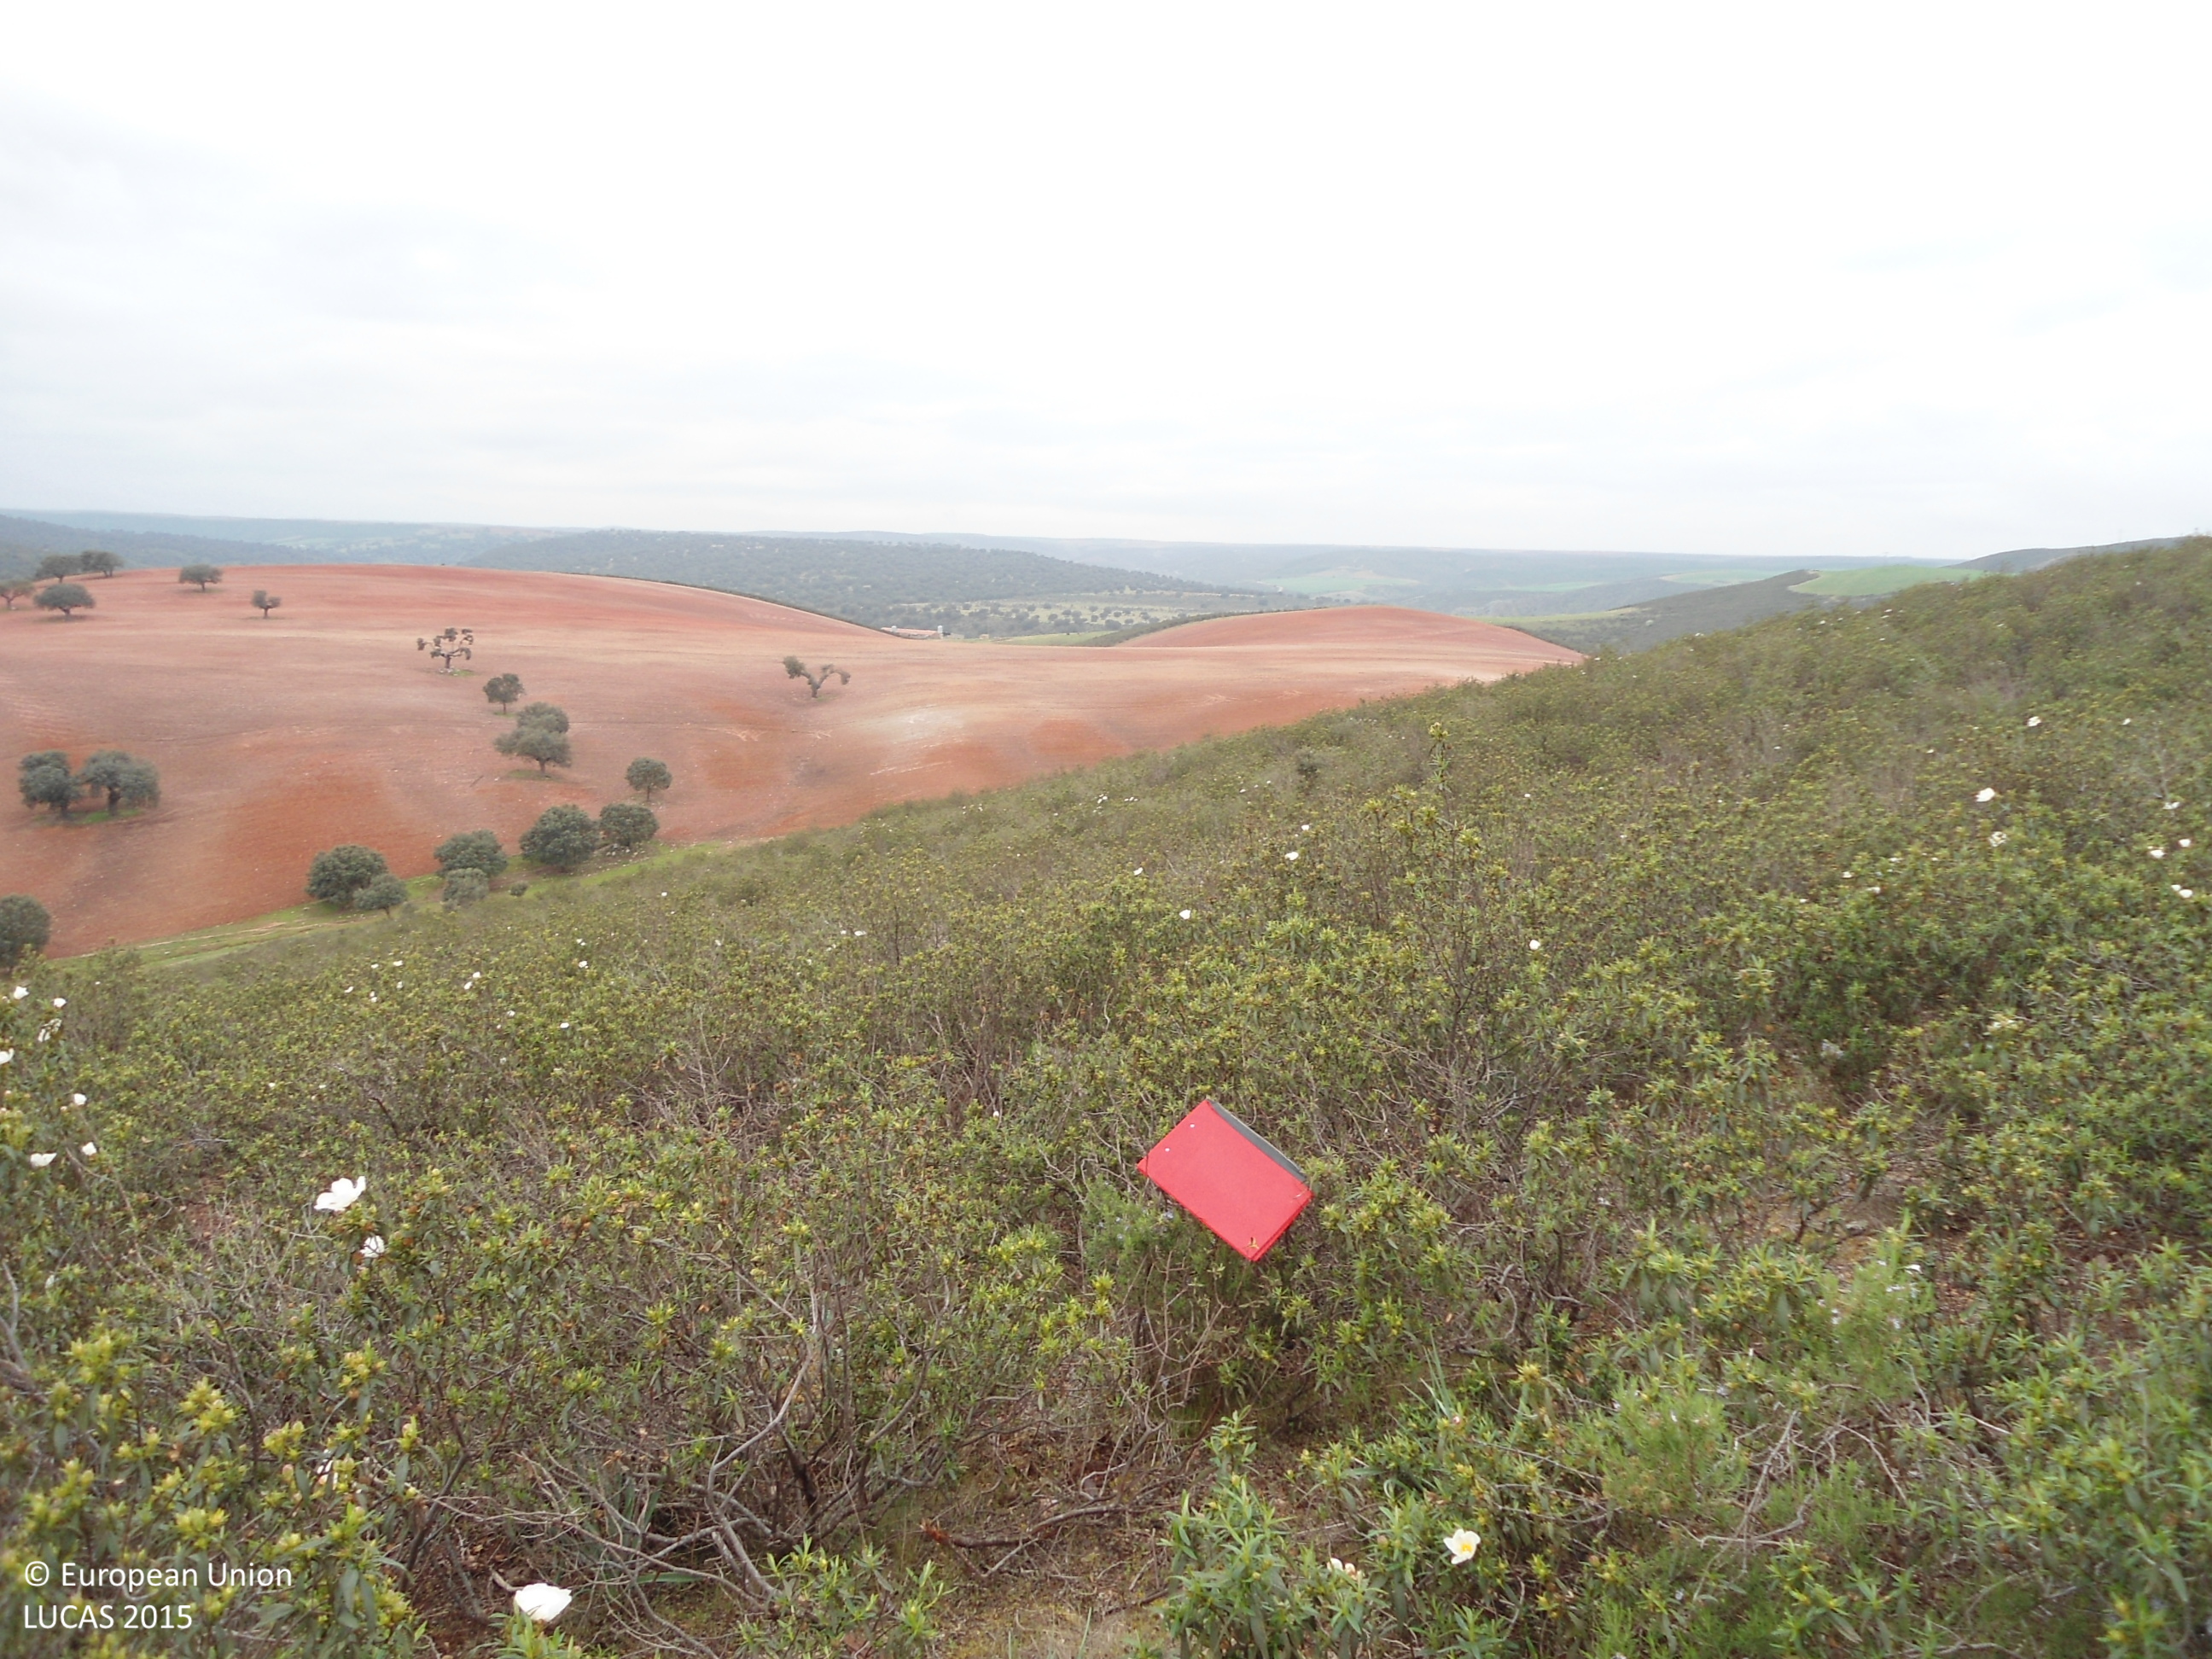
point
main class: Shrubland
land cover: Shrubland without tree cover
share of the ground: > 75 %
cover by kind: shrubs 100 %
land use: Abandoned areas
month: April
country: ES
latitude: 41.5256
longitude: -5.8481
